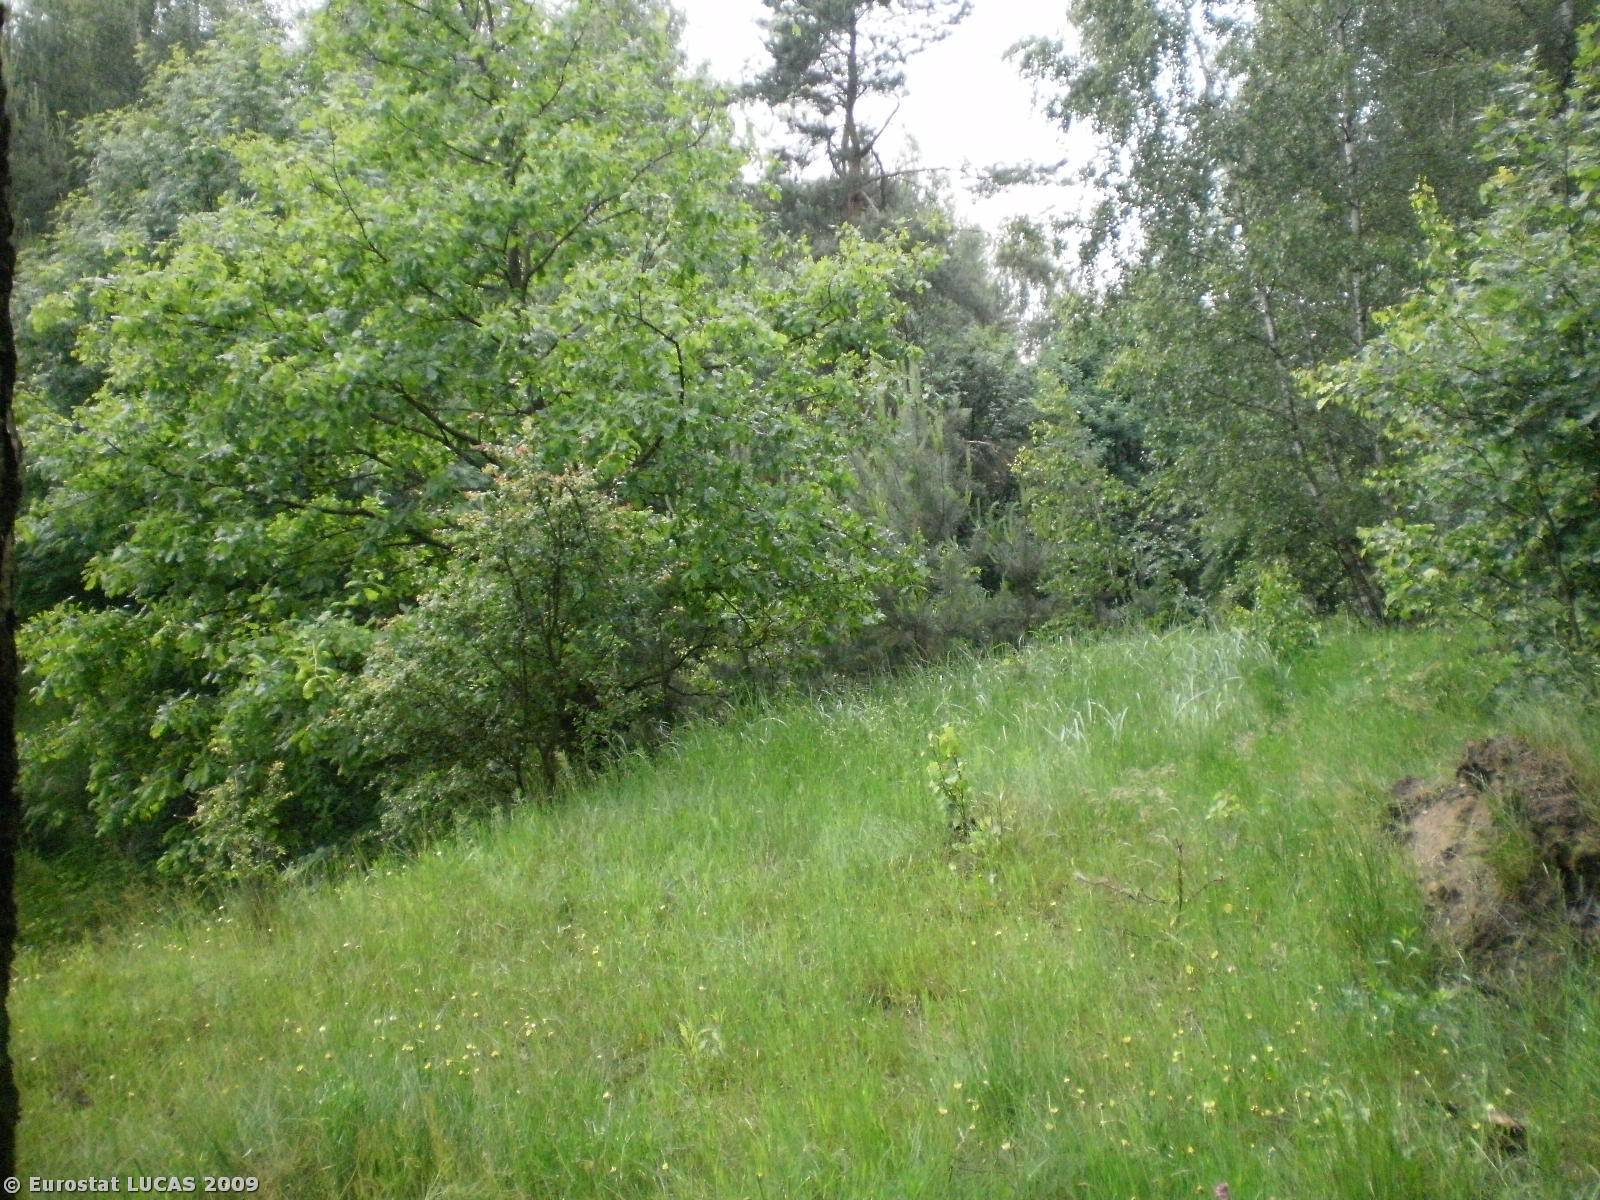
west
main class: Woodland
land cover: Mixed woodland
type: hemiboreal forest and nemoral coniferous forest and mixed broadleaved-coniferous forest
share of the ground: > 75 %
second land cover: Grassland with sparse tree/shrub cover
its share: 50 - 75 %
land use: Forestry
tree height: > 5 m
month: June
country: PL
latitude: 53.4335
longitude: 19.8592
